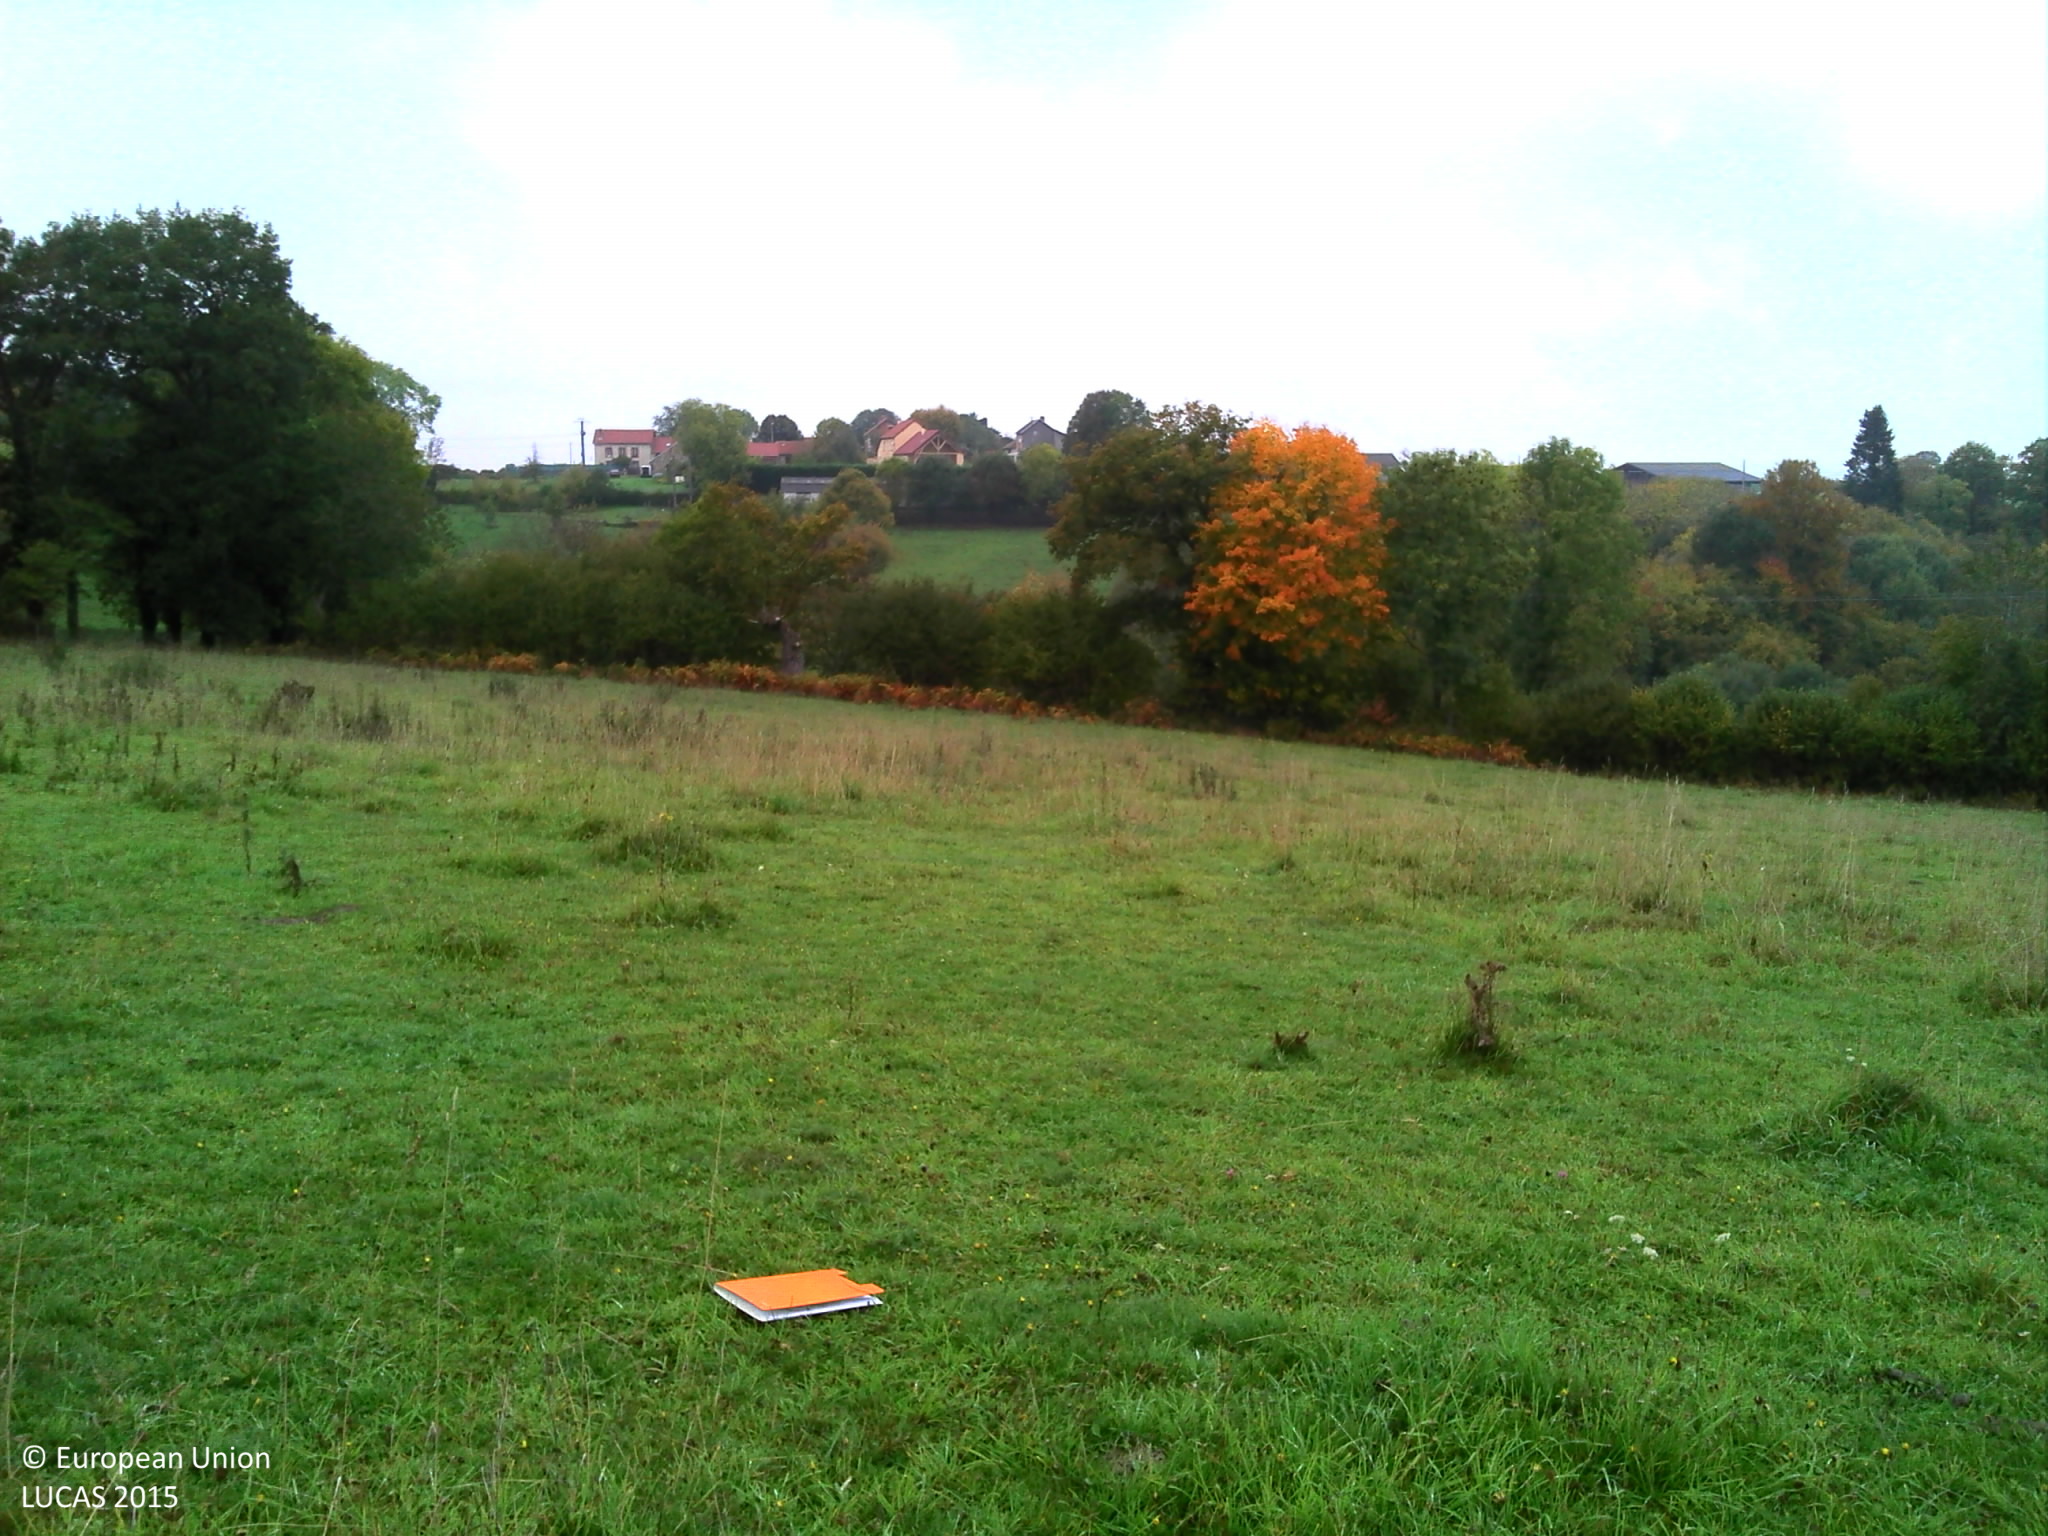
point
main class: Grassland
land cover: Grassland without tree/shrub cover
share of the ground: > 75 %
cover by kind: herbaceous plants 100 %
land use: Agriculture (excluding fallow land and kitchen gardens)
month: October
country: FR
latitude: 45.9662
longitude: 2.8361
